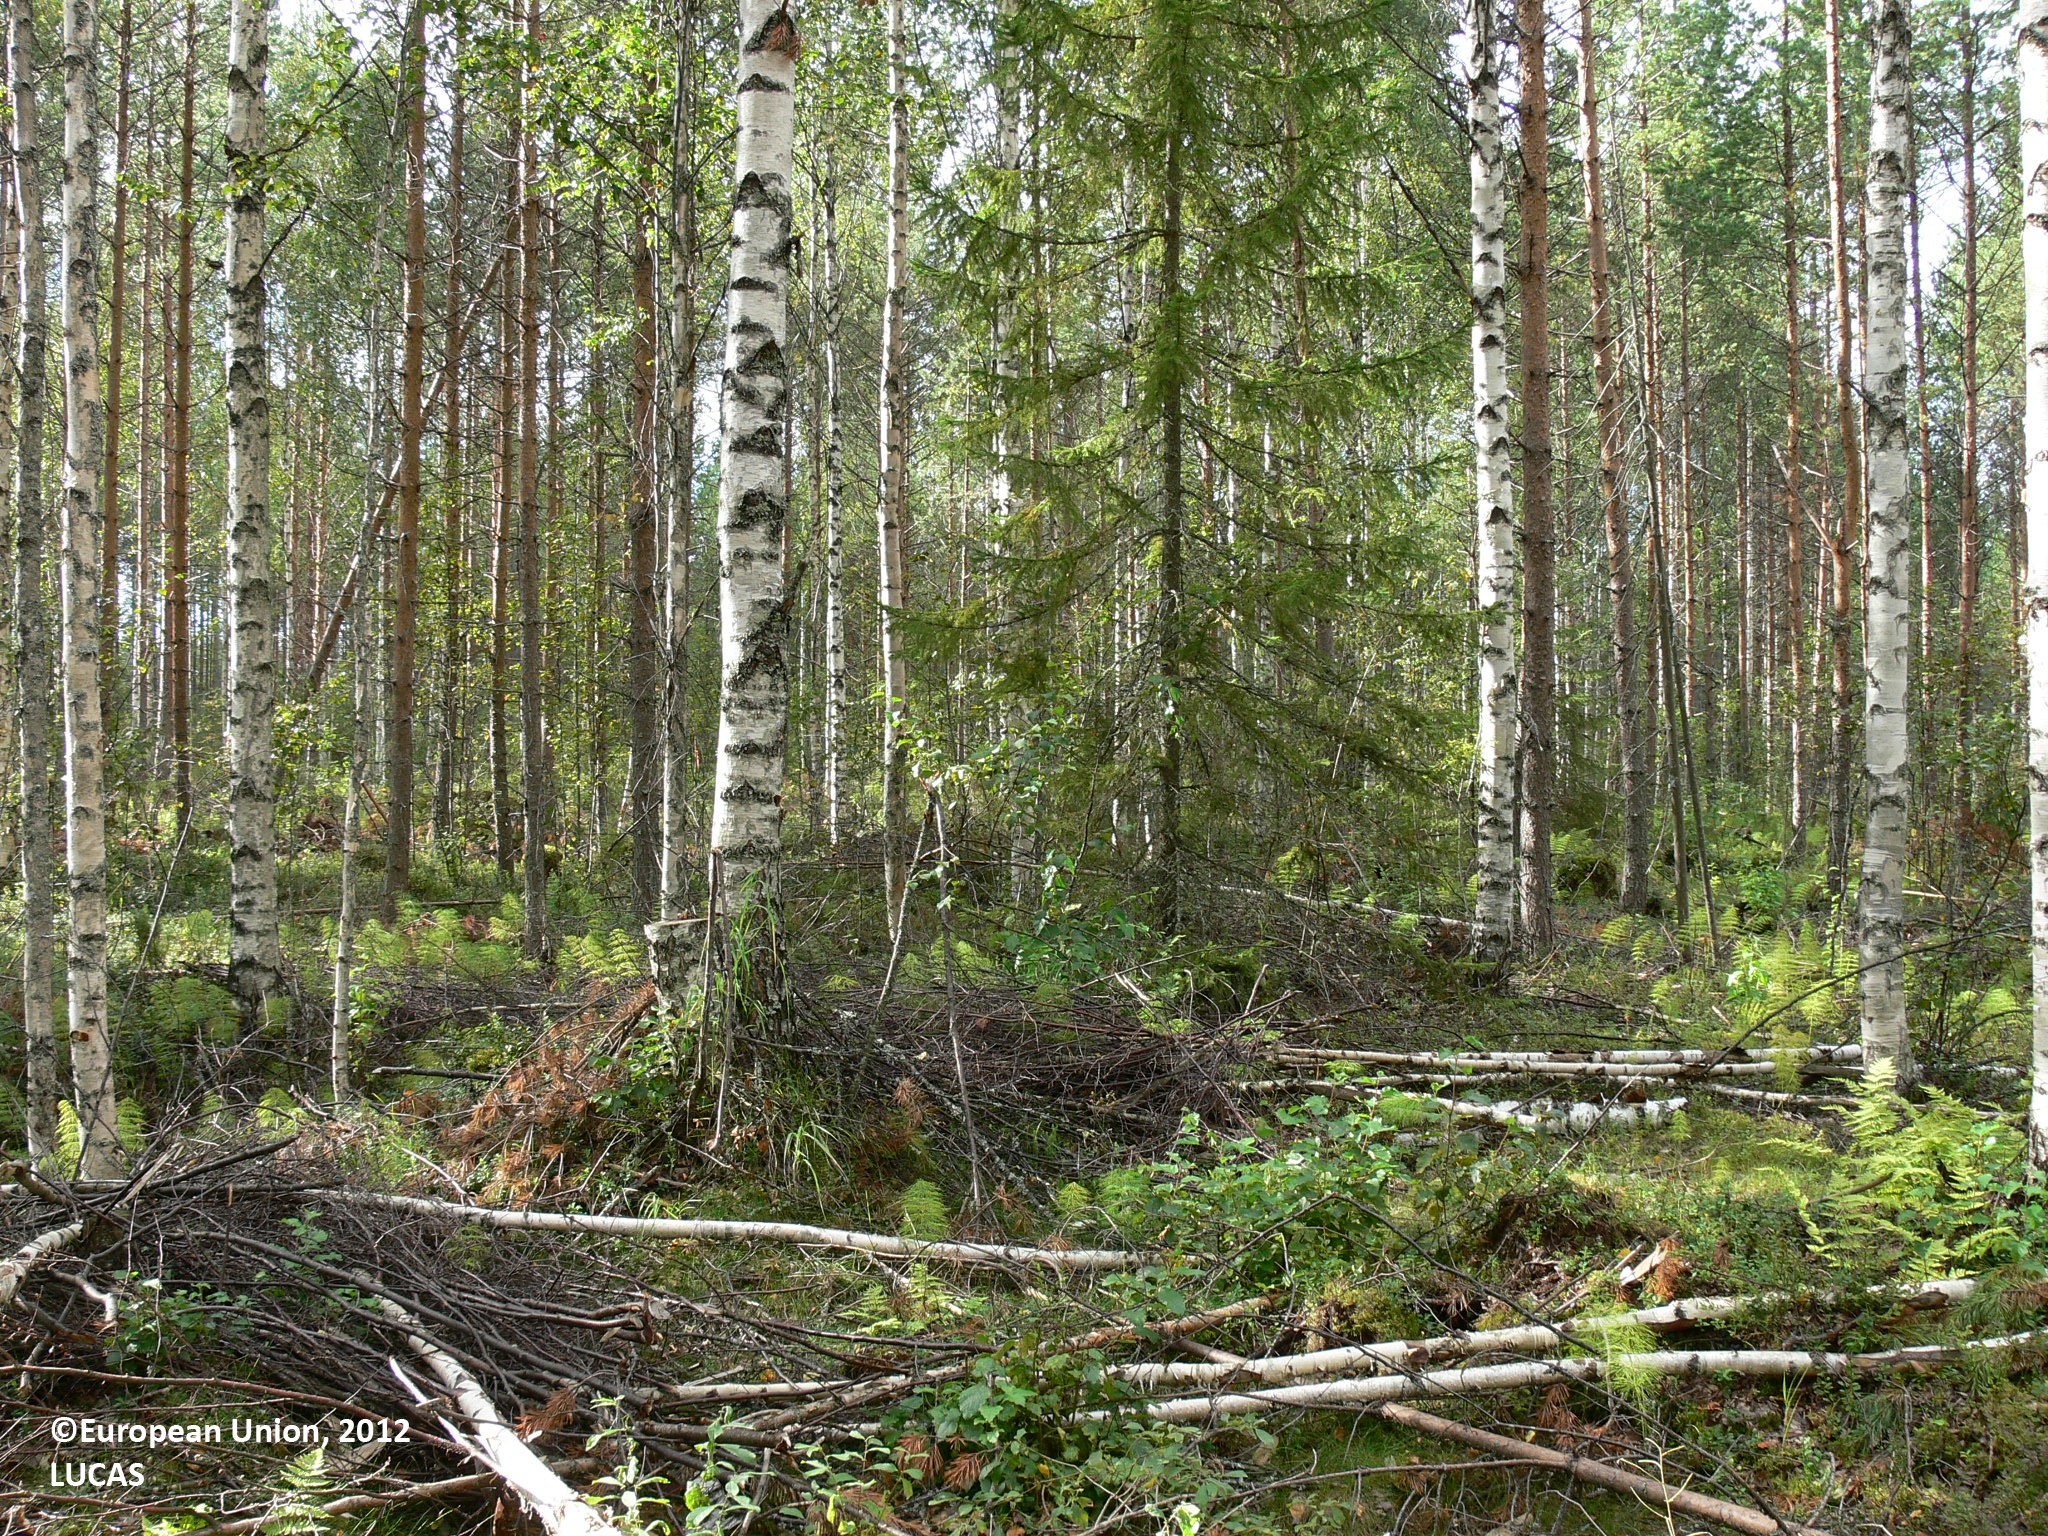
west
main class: Woodland
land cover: Pine dominated mixed woodland
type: boreal forest
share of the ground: 50 - 75 %
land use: Forestry
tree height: > 5 m
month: August
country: FI
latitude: 63.3255
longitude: 30.2888
